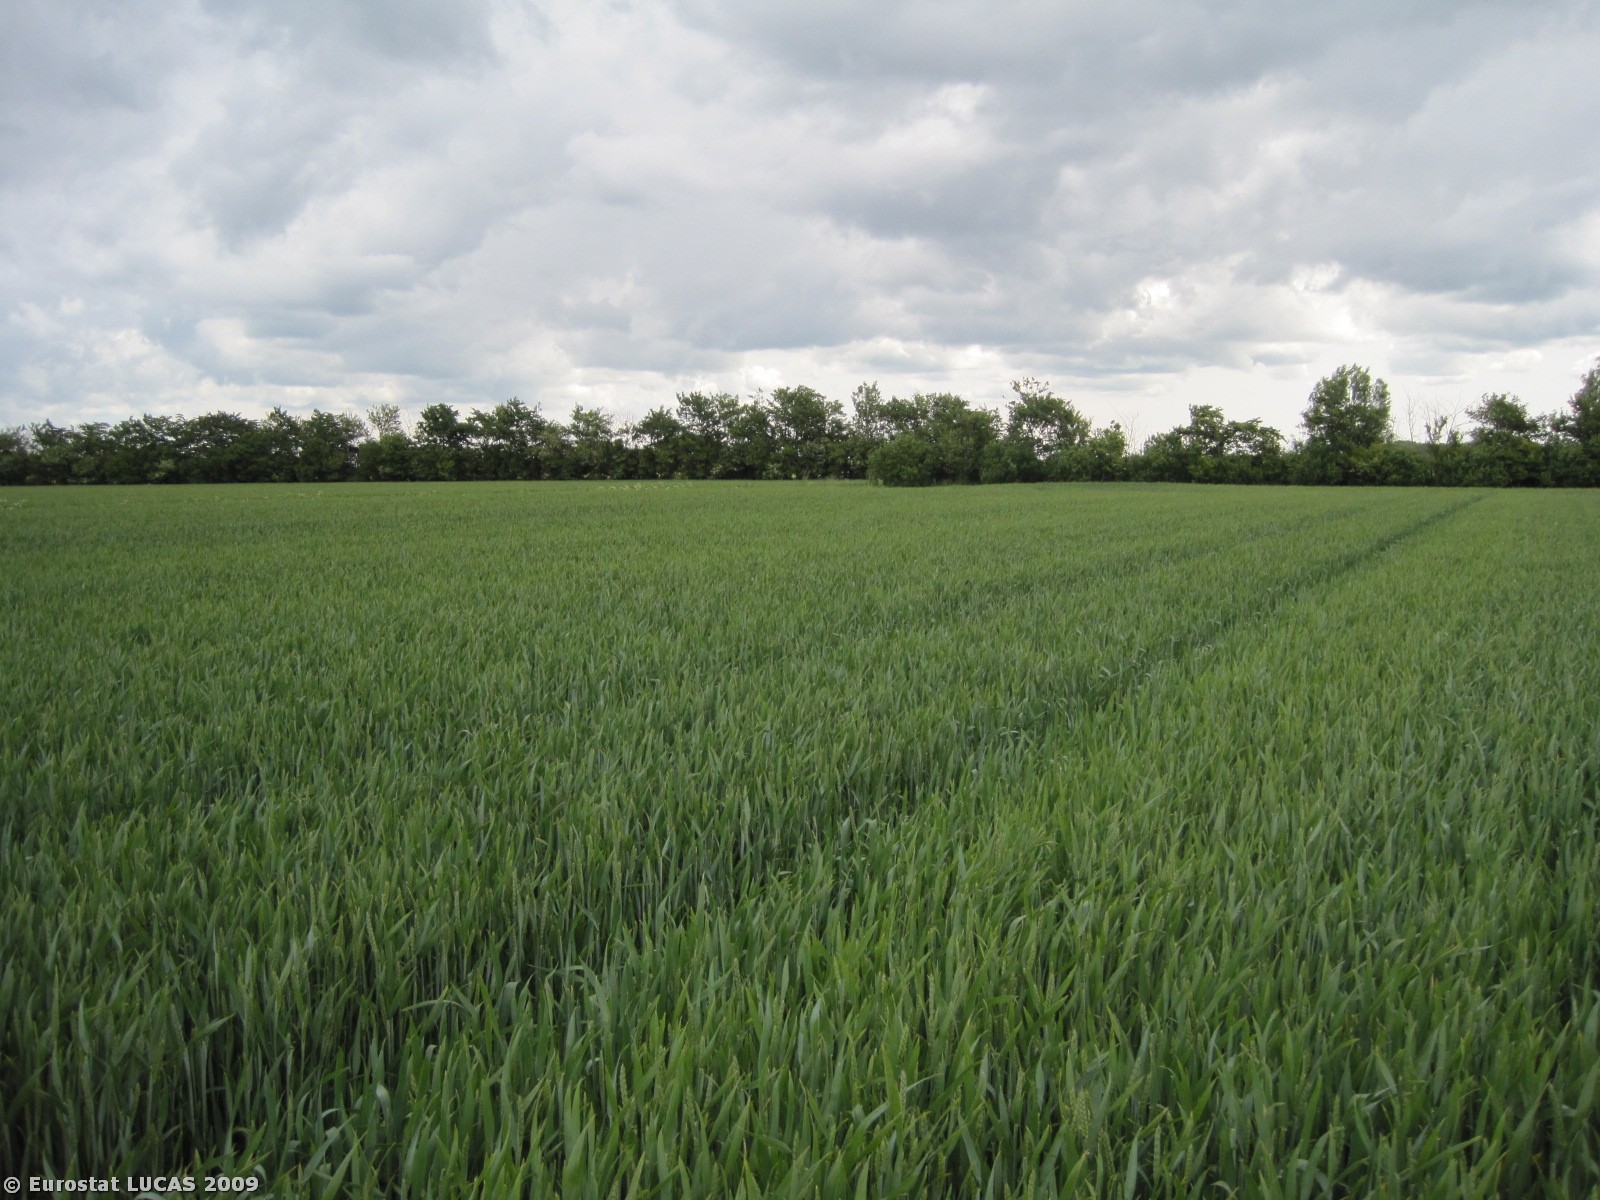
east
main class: Cropland
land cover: Common wheat
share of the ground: > 75 %
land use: Agriculture (excluding fallow land and kitchen gardens)
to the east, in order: Common wheat; Grass margins; Ditches and canals; Grass margins; Common wheat; Grass margins; Broadleaved woodland; Grass margins; Barley
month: June
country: DK
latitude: 57.2662
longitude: 9.7848
